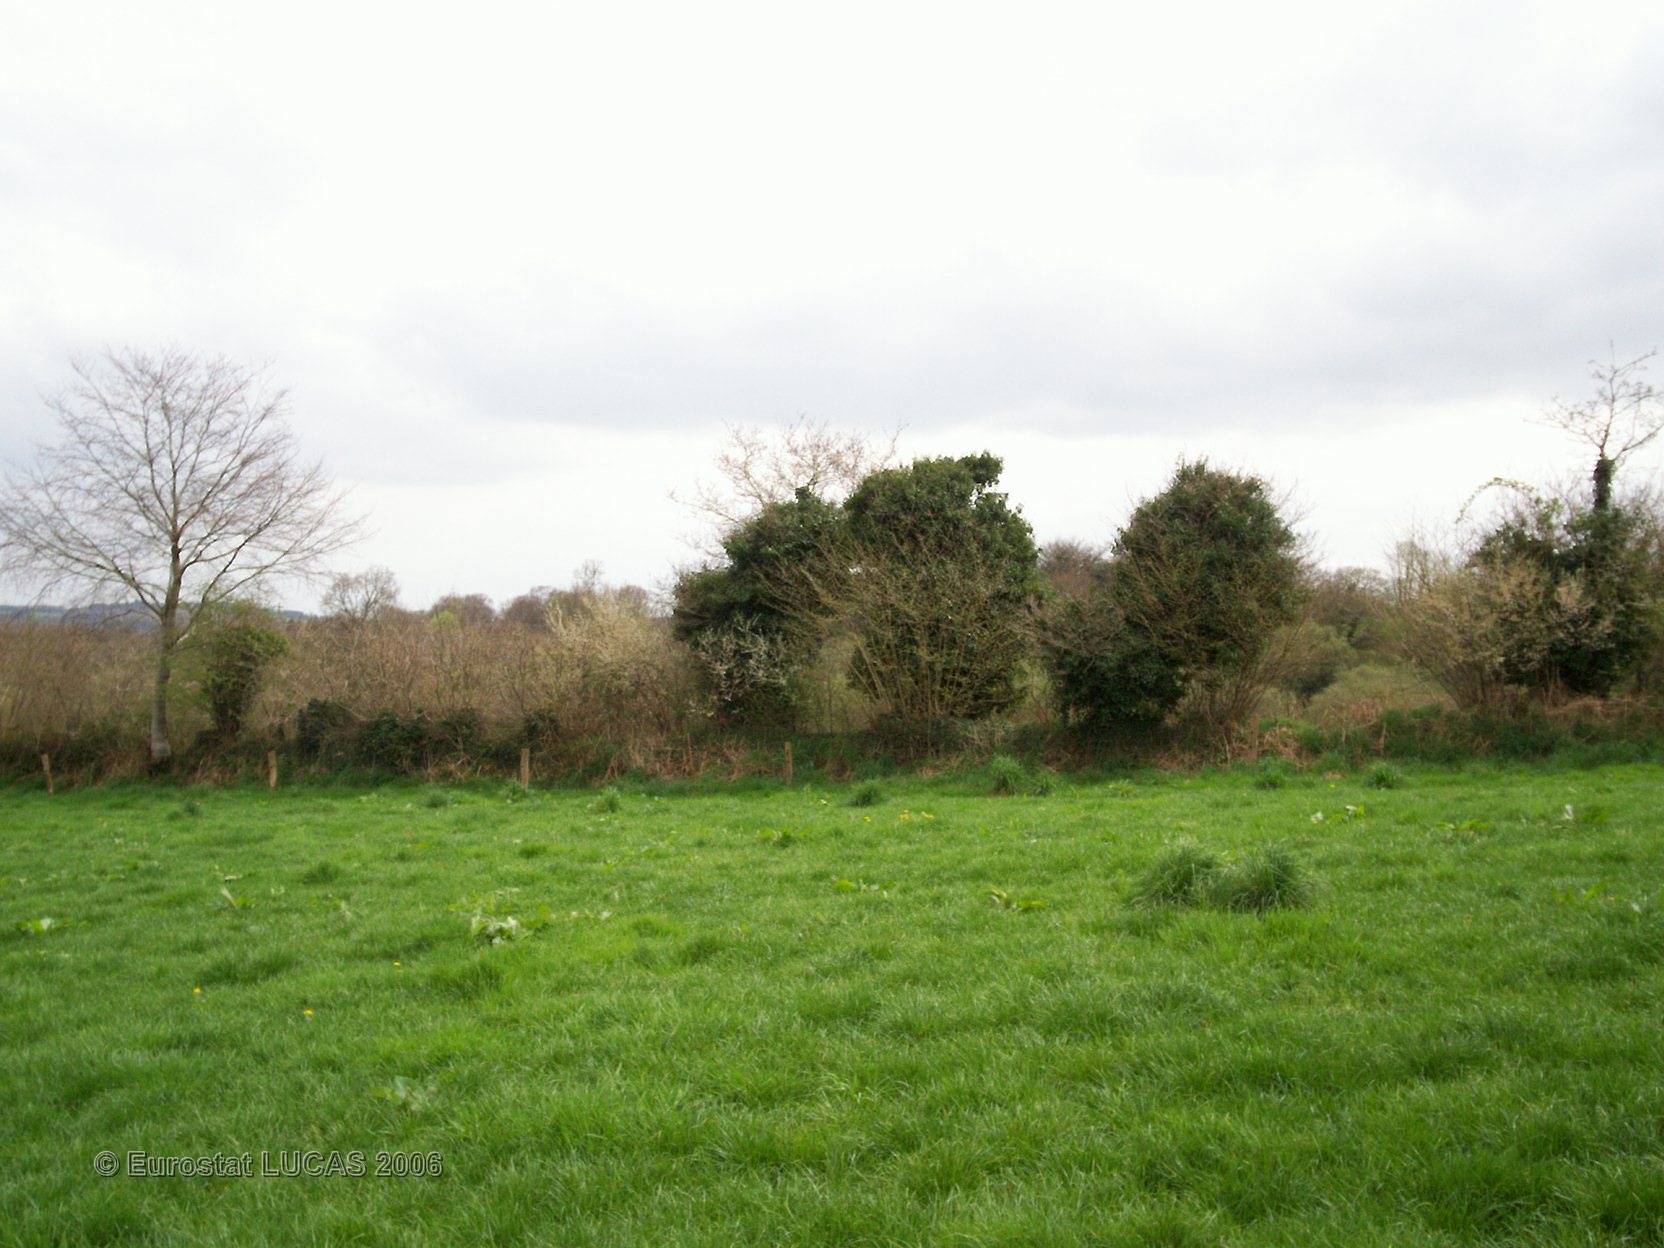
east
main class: Grassland
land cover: Grassland without tree/shrub cover
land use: Agriculture (excluding fallow land and kitchen gardens)
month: April
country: FR
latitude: 48.3742
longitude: -3.7867
